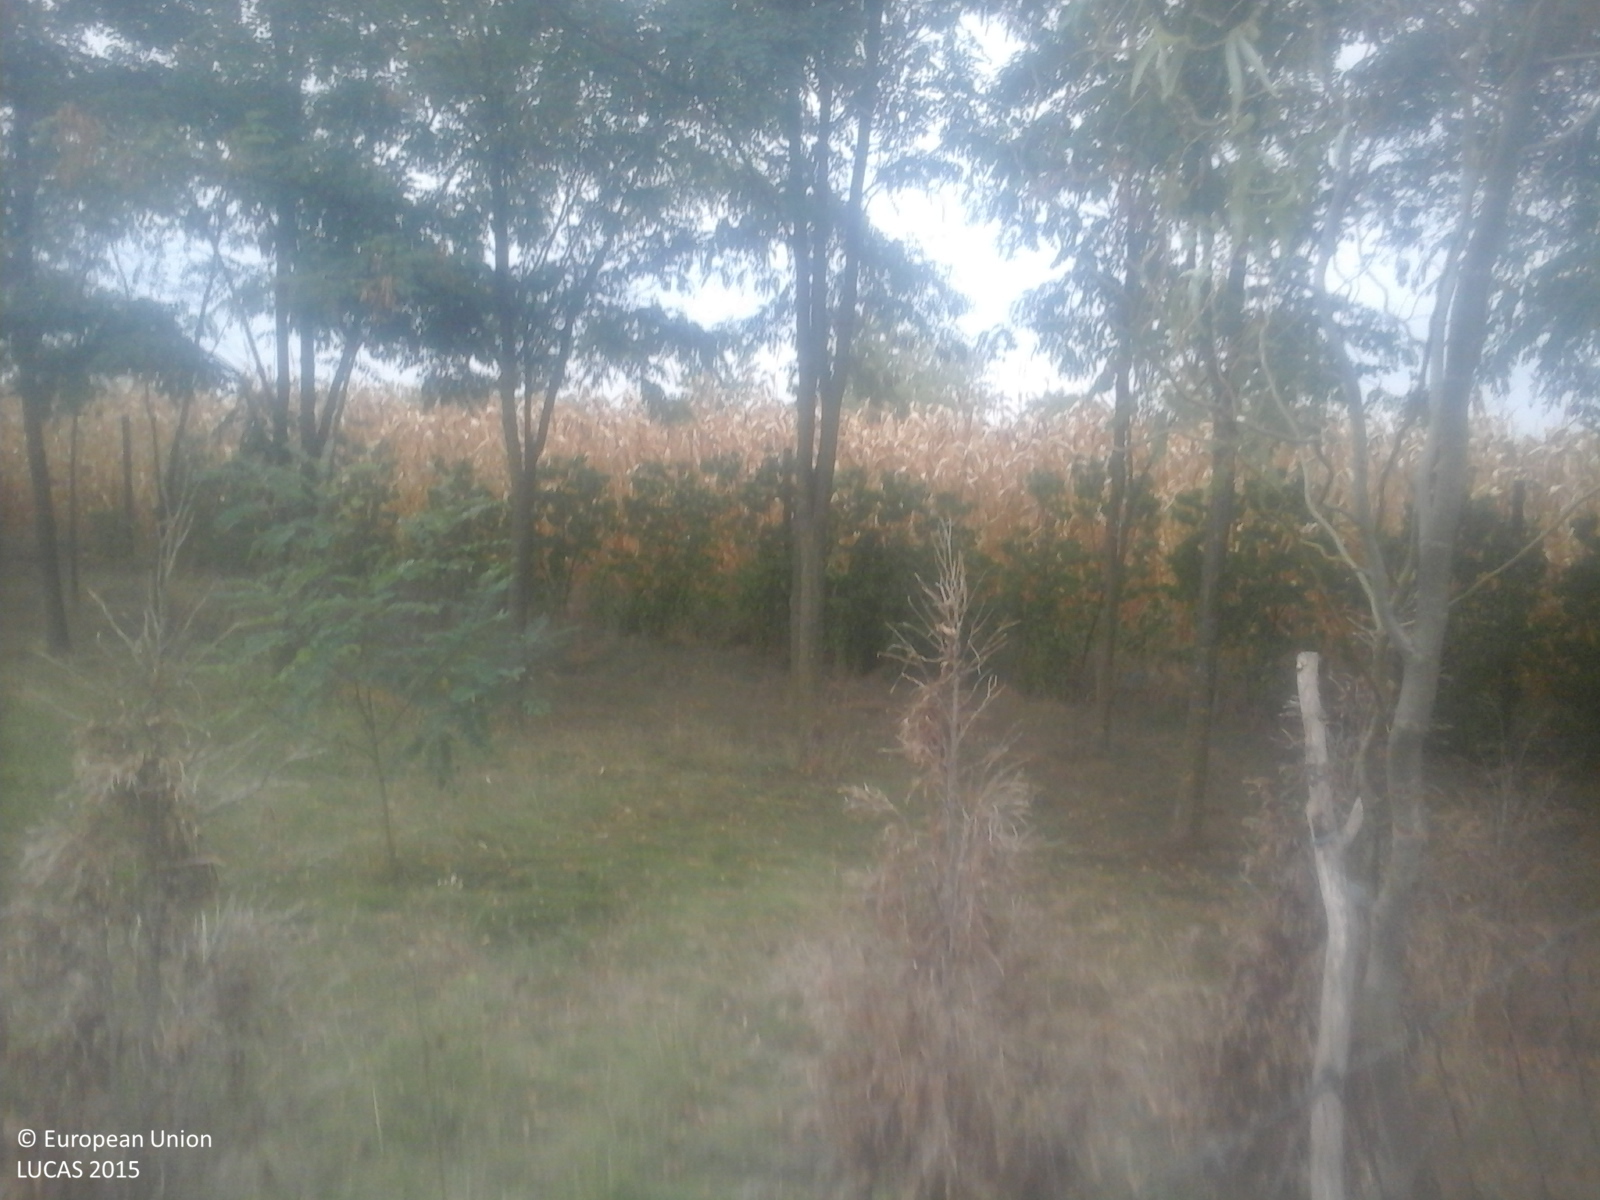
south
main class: Grassland
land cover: Grassland with sparse tree/shrub cover
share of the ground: > 75 %
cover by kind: herbaceous plants 85 %, shrubs 10 %, broadleaved forest trees 5 %
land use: Agriculture (excluding fallow land and kitchen gardens)
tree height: < 5 m
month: September
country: RO
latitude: 47.6597
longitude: 22.4539
